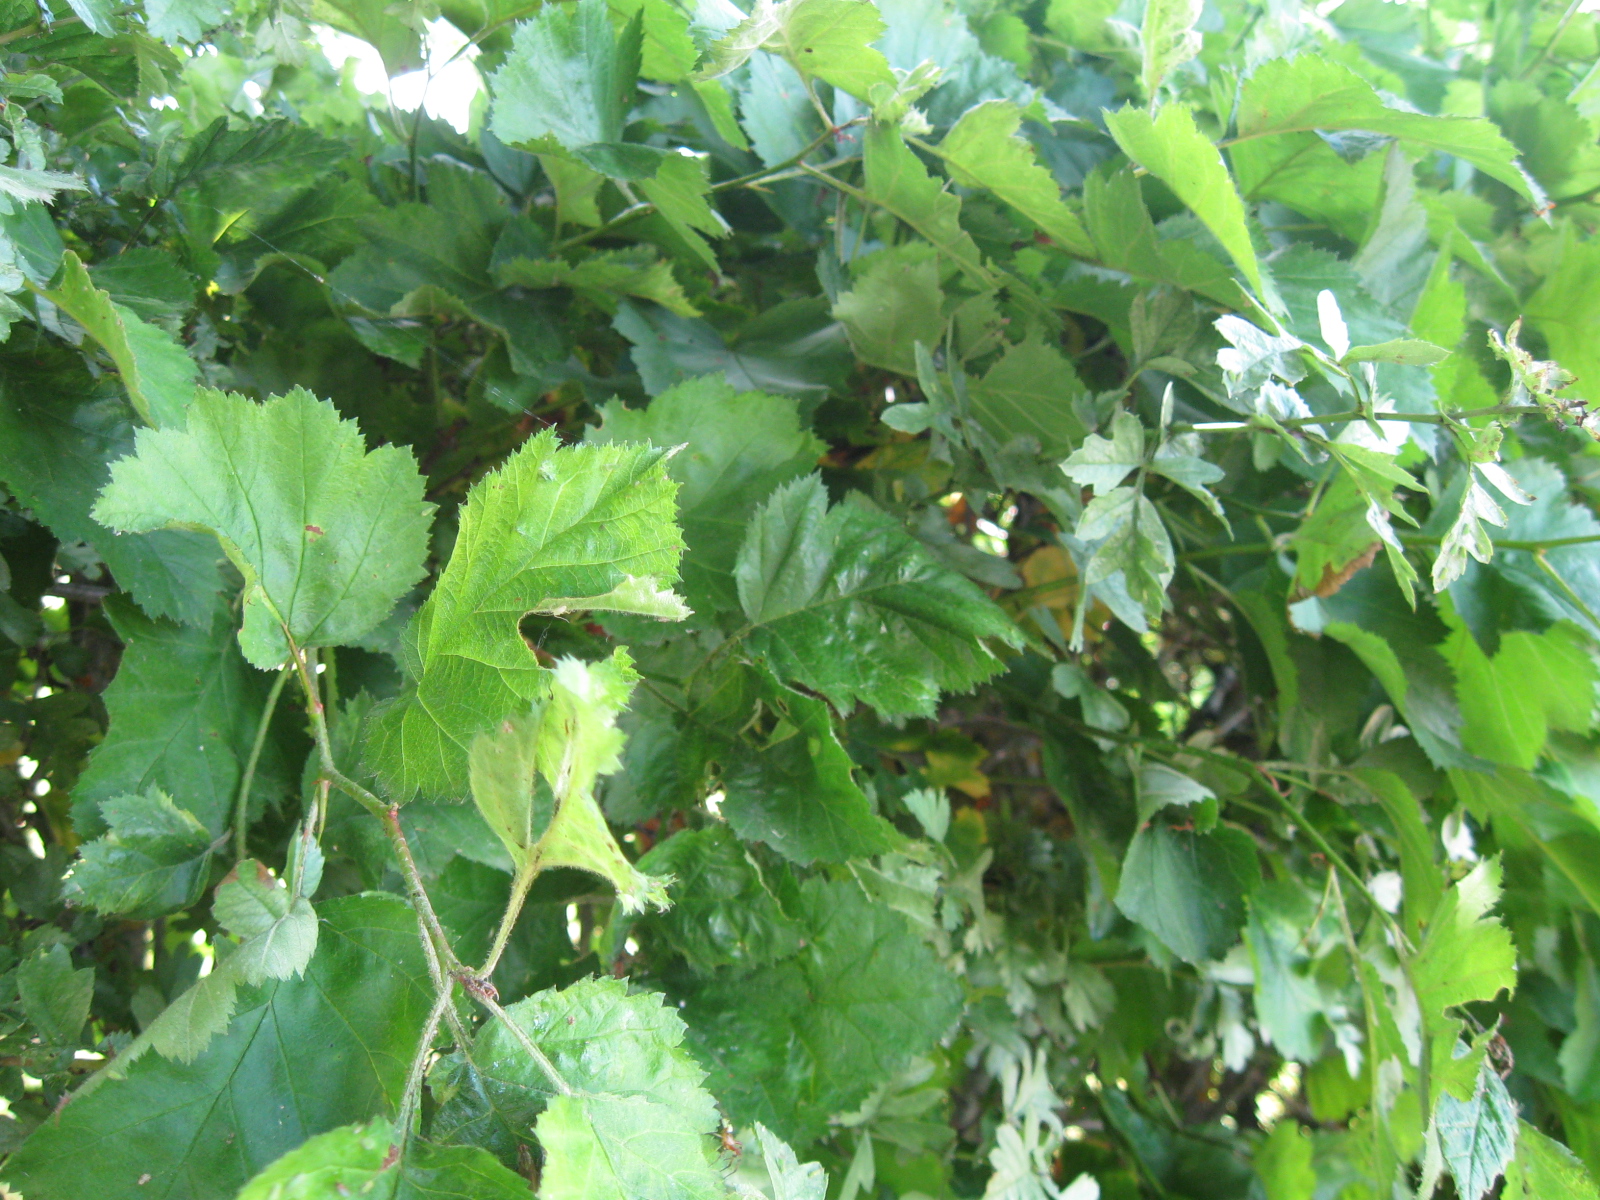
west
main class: Grassland
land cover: Grassland without tree/shrub cover
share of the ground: > 75 %
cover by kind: herbaceous plants 100 %
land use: Residential
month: June
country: LT
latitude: 54.4860
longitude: 24.5999
